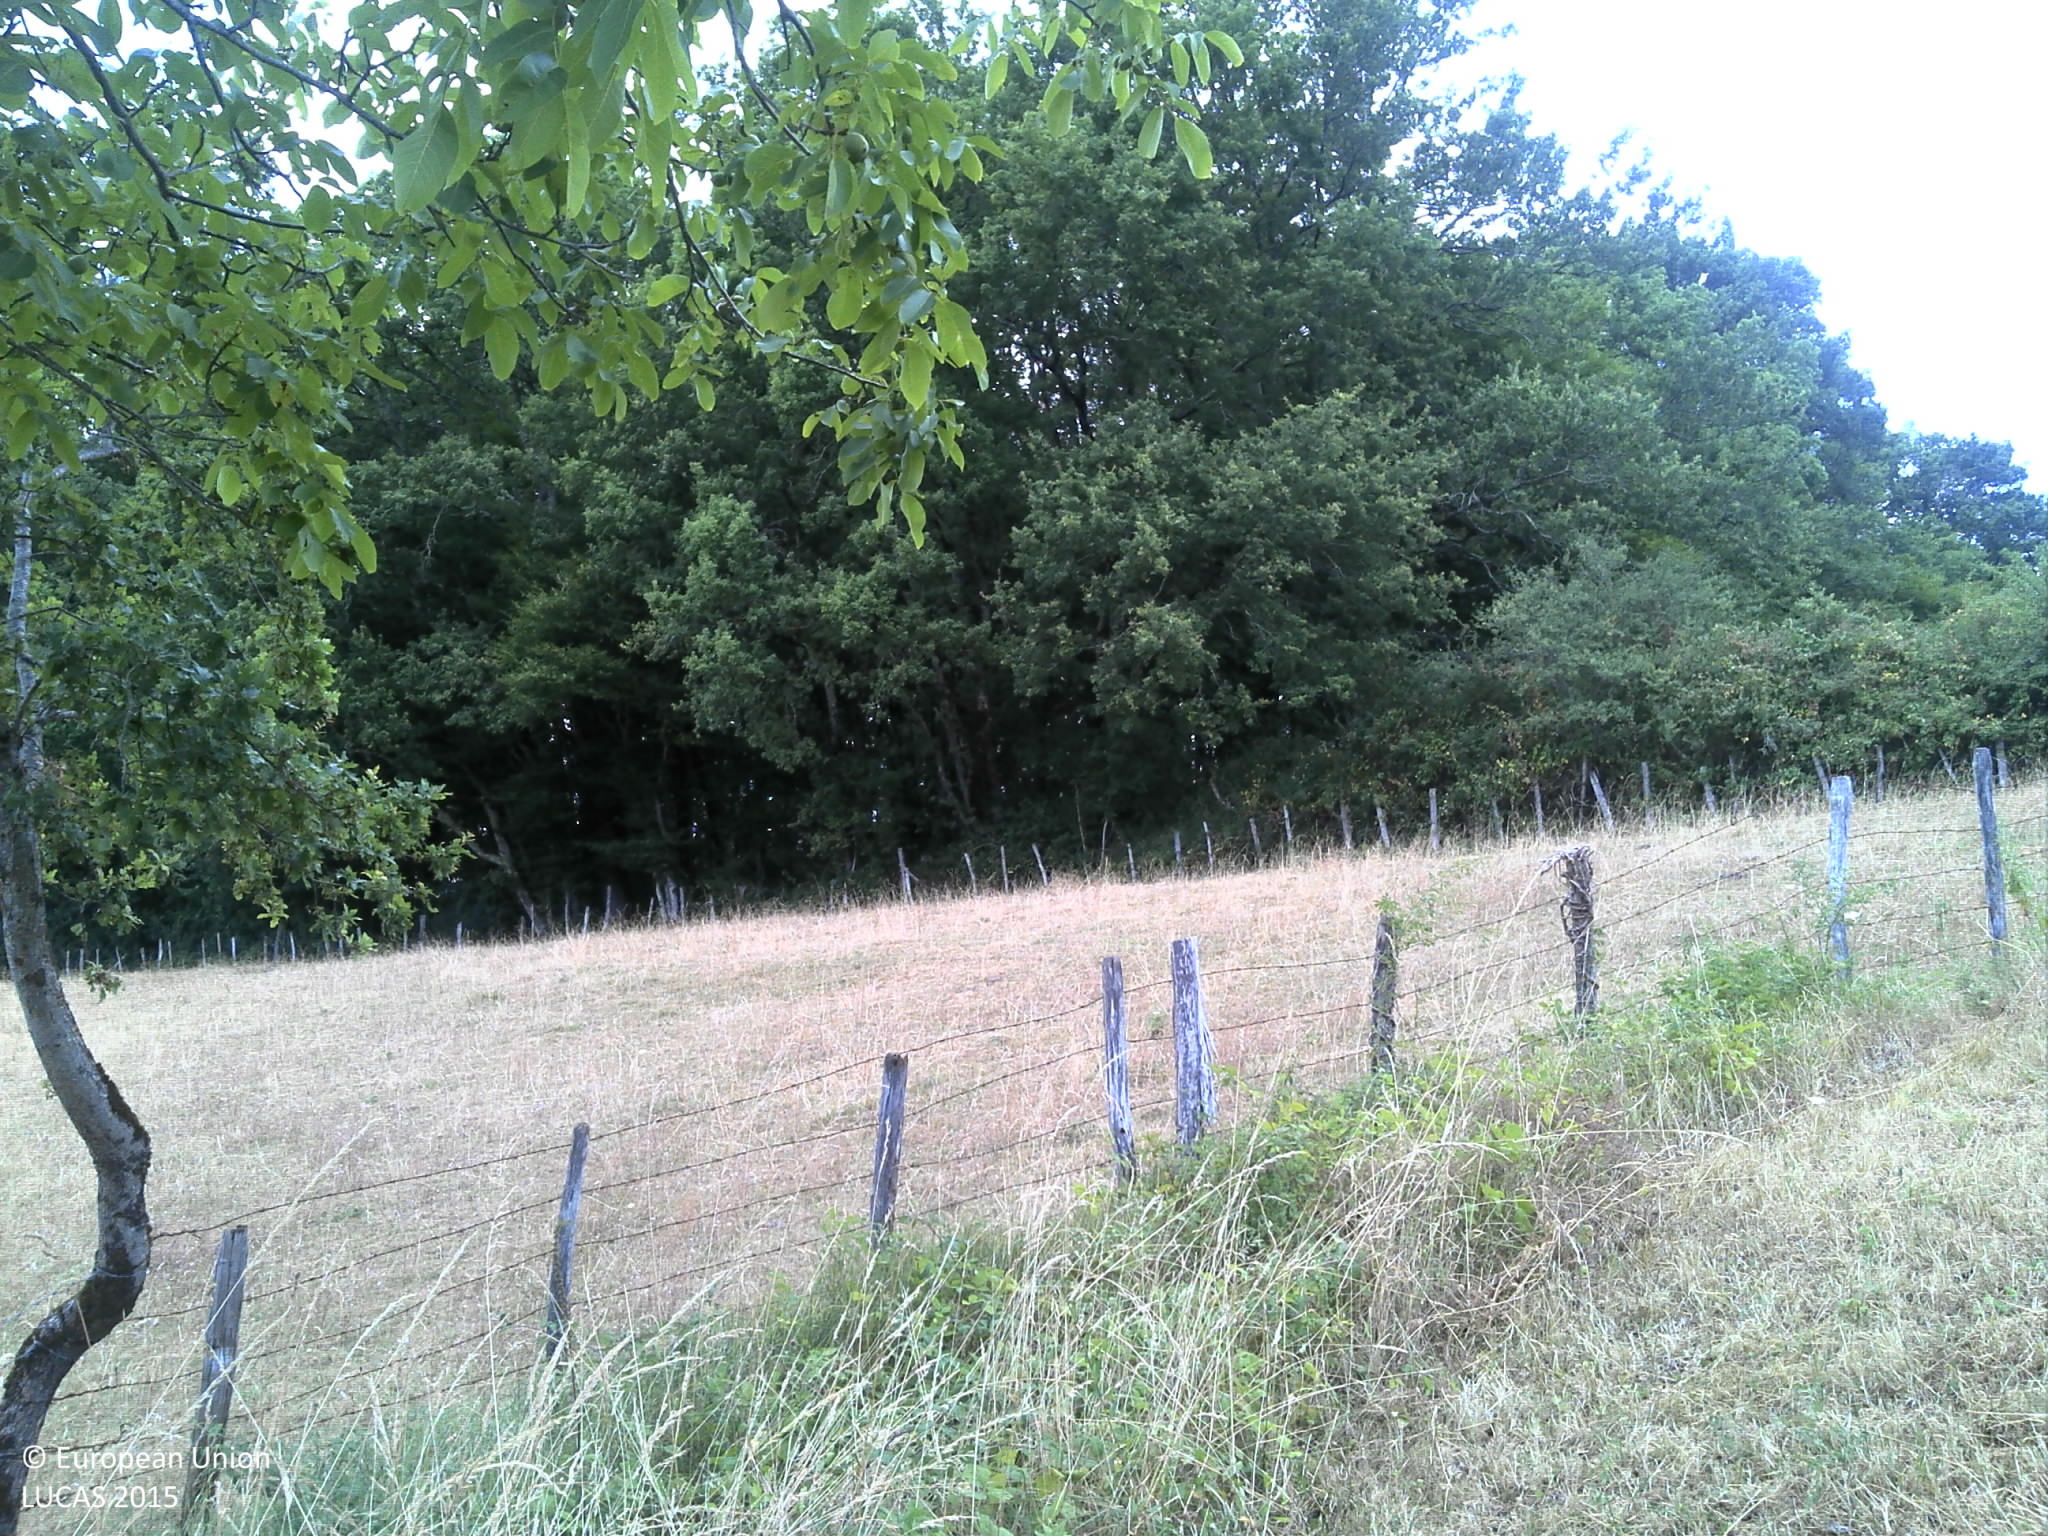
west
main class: Grassland
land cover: Grassland without tree/shrub cover
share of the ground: > 75 %
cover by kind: herbaceous plants 100 %
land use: Agriculture (excluding fallow land and kitchen gardens)
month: July
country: FR
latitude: 44.9513
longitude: 1.8222
